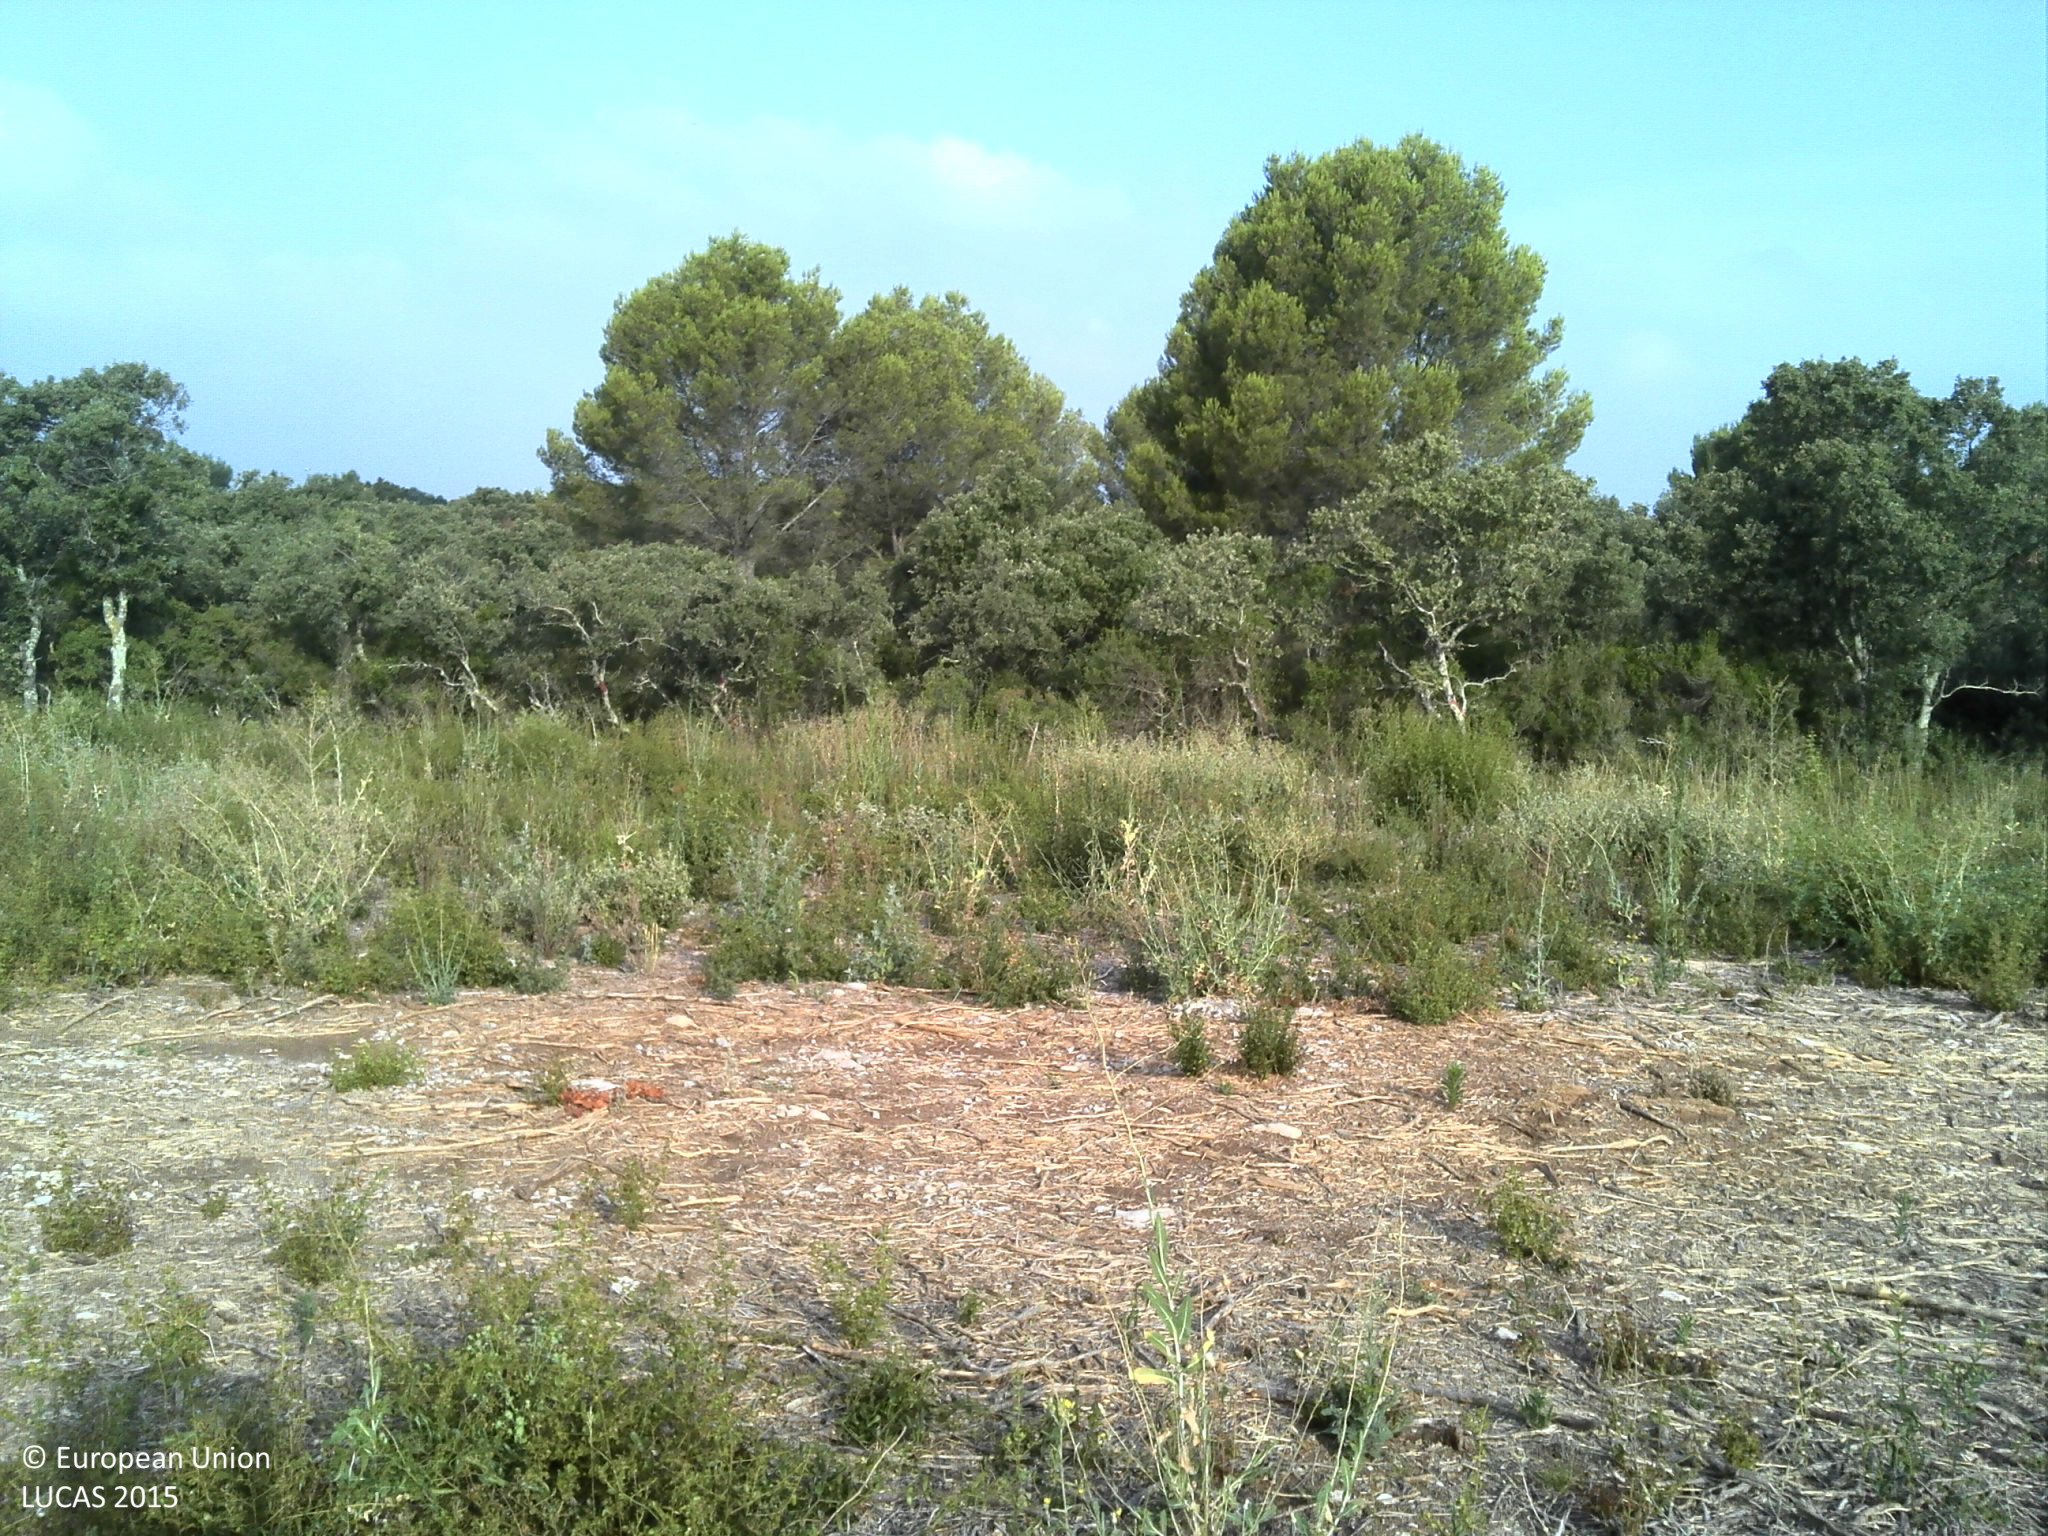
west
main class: Shrubland
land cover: Shrubland with sparse tree cover
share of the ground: > 75 %
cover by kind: shrubs 65 %, herbaceous plants 10 %, consolidated bare surface 10 %, unconsolidated bare surface 10 %, broadleaved forest trees 5 %
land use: Semi-natural and natural areas not in use
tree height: < 5 m
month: July
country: FR
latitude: 43.6702
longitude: 3.9939
